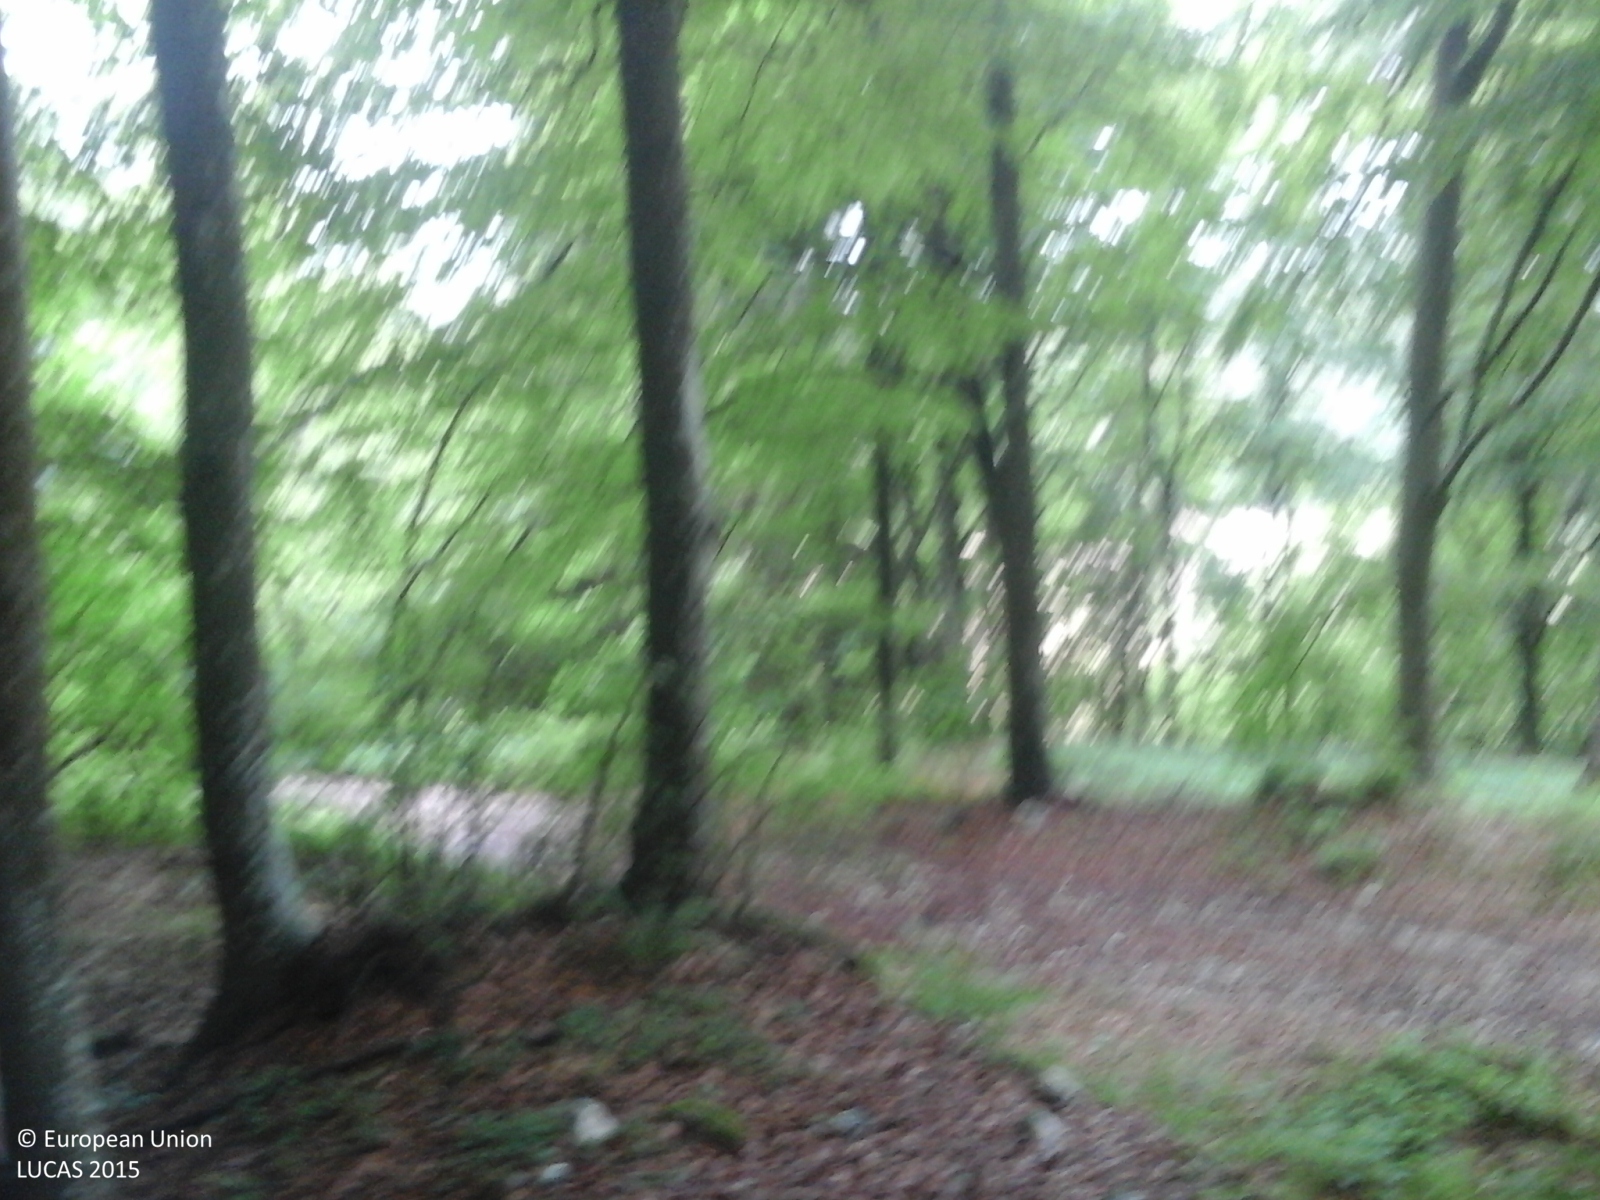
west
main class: Woodland
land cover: Broadleaved woodland
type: mountainous beech forest
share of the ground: > 75 %
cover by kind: broadleaved forest trees 95 %, coniferous forest trees 5 %
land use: Forestry
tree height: > 5 m
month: May
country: IT
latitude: 45.7886
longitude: 10.9376
